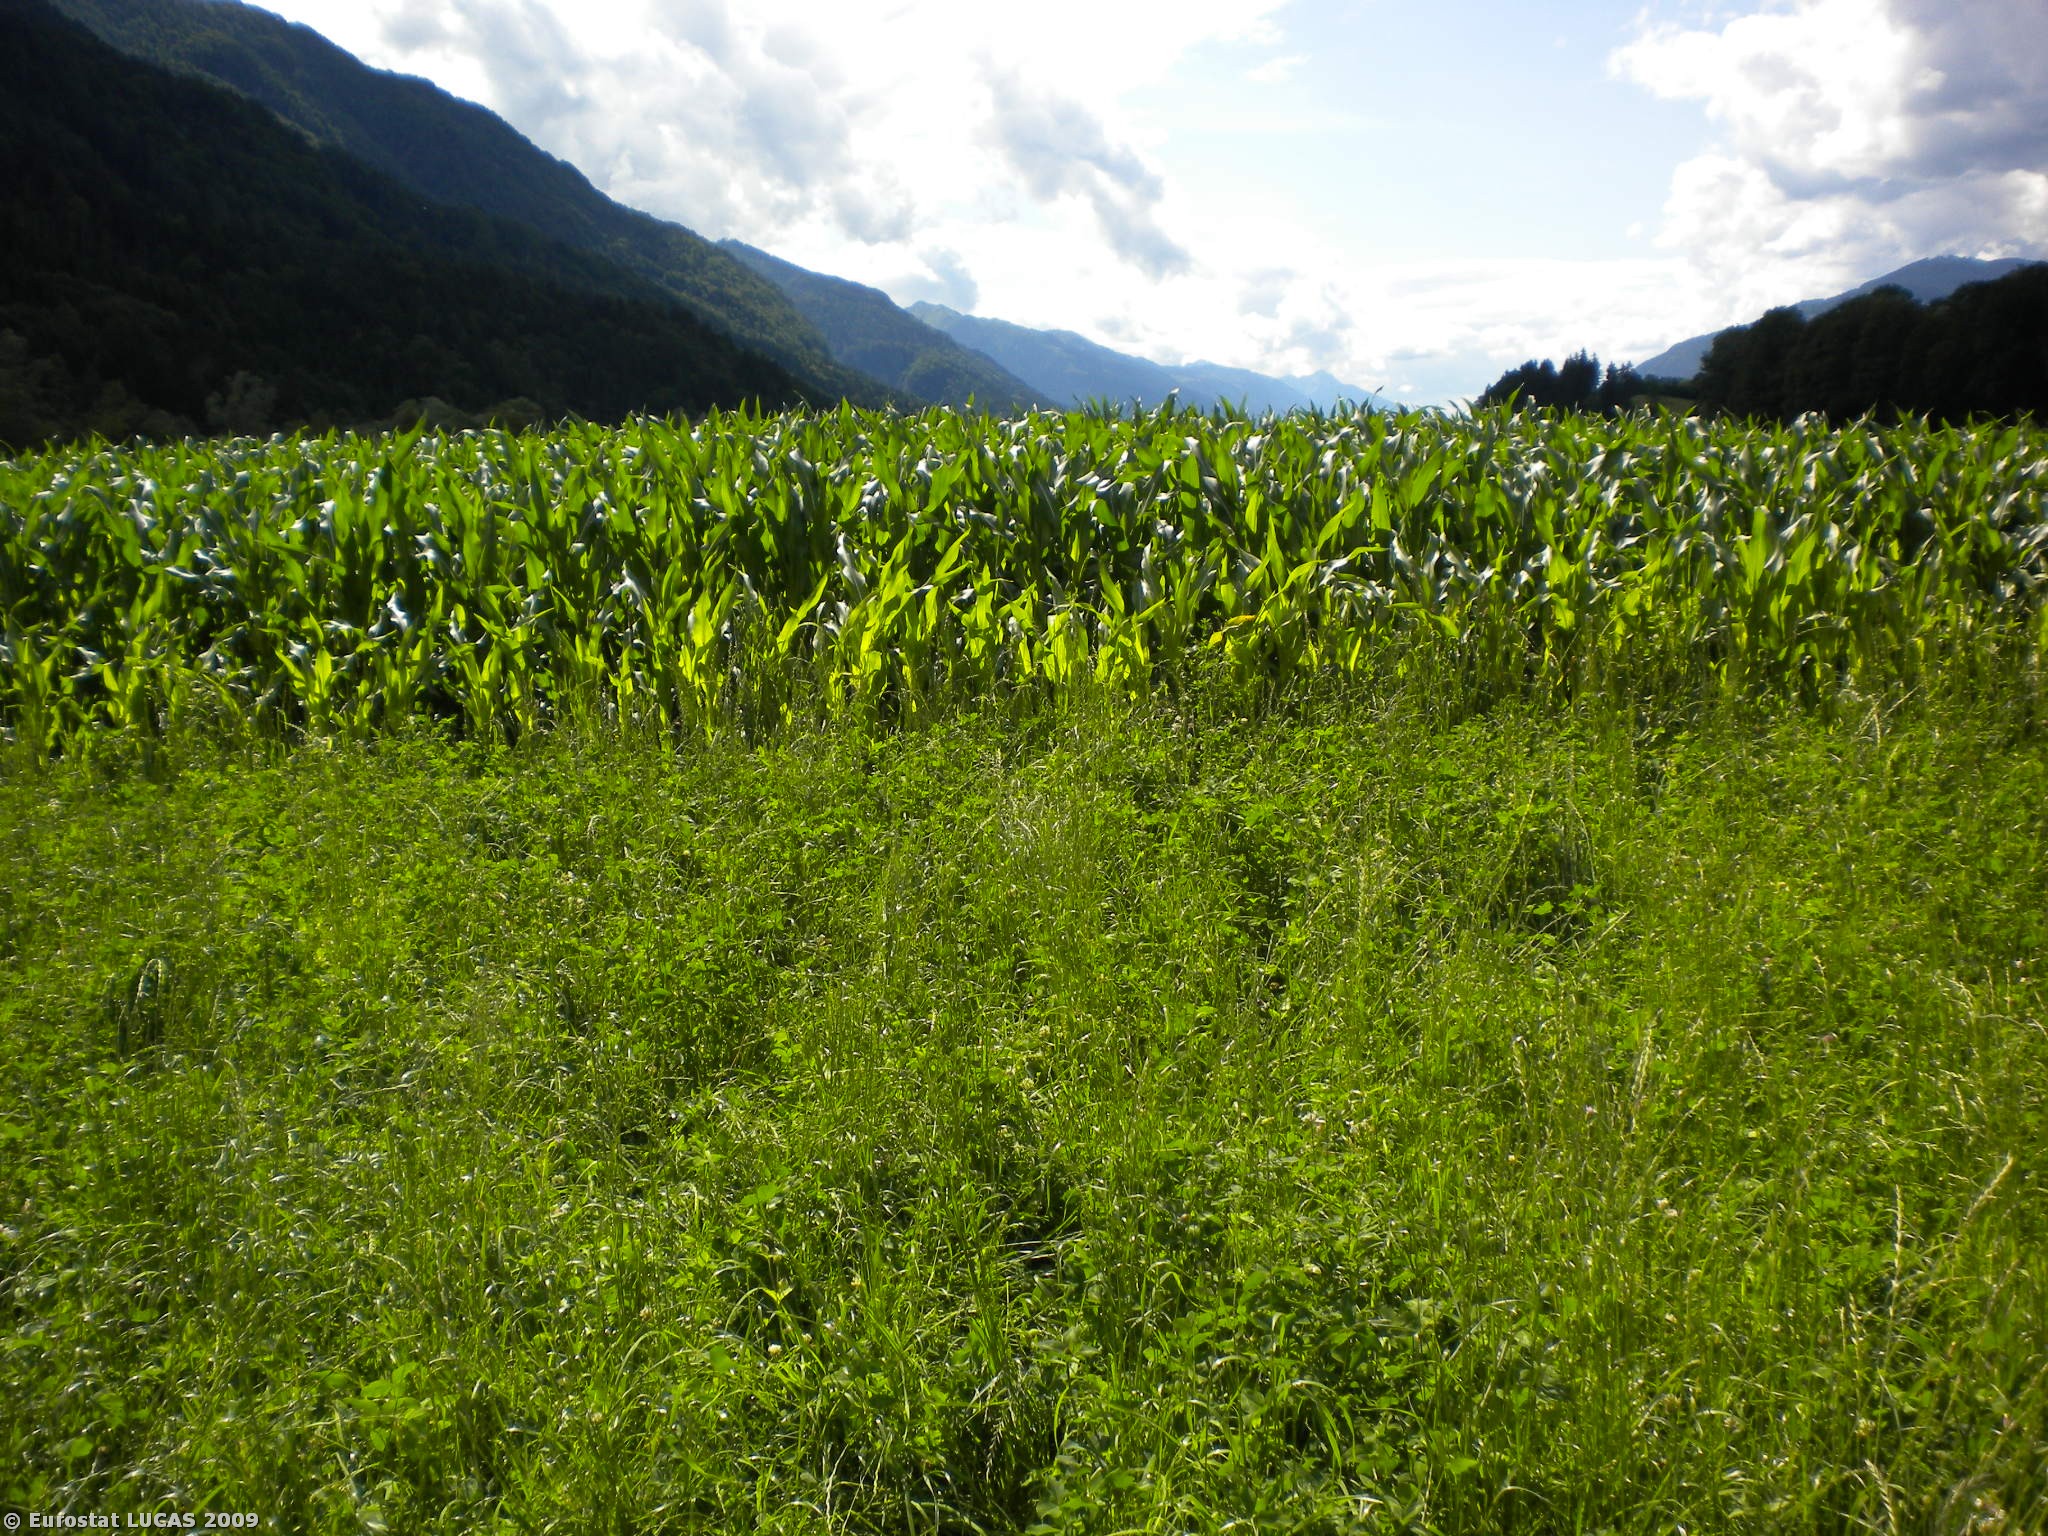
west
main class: Grassland
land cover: Grassland without tree/shrub cover
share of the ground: > 75 %
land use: Agriculture (excluding fallow land and kitchen gardens)
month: July
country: AT
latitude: 46.6027
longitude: 13.4306
